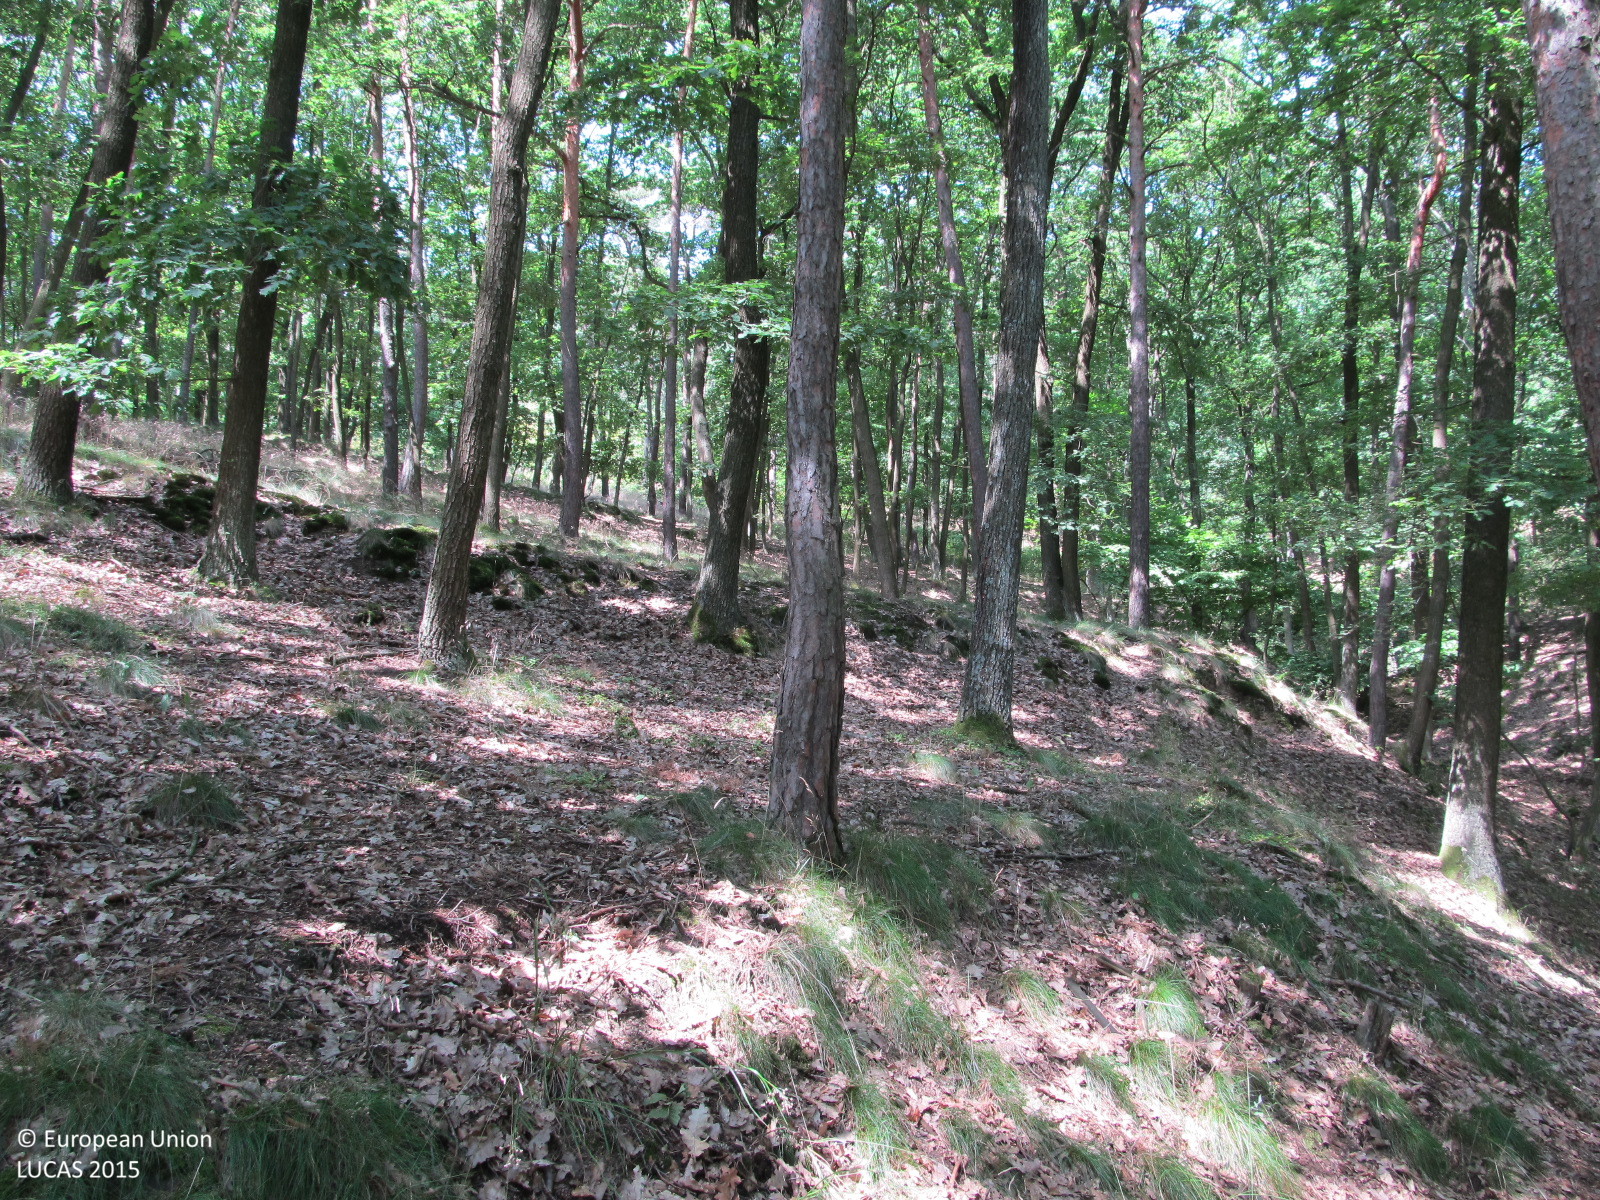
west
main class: Woodland
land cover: Other mixed woodland
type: mountainous beech forest
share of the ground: > 75 %
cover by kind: broadleaved forest trees 50 %, coniferous forest trees 25 %, shrubs 10 %, unconsolidated bare surface 10 %, herbaceous plants 5 %
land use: Forestry
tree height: > 5 m
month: July
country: AT
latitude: 48.7844
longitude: 15.9521
